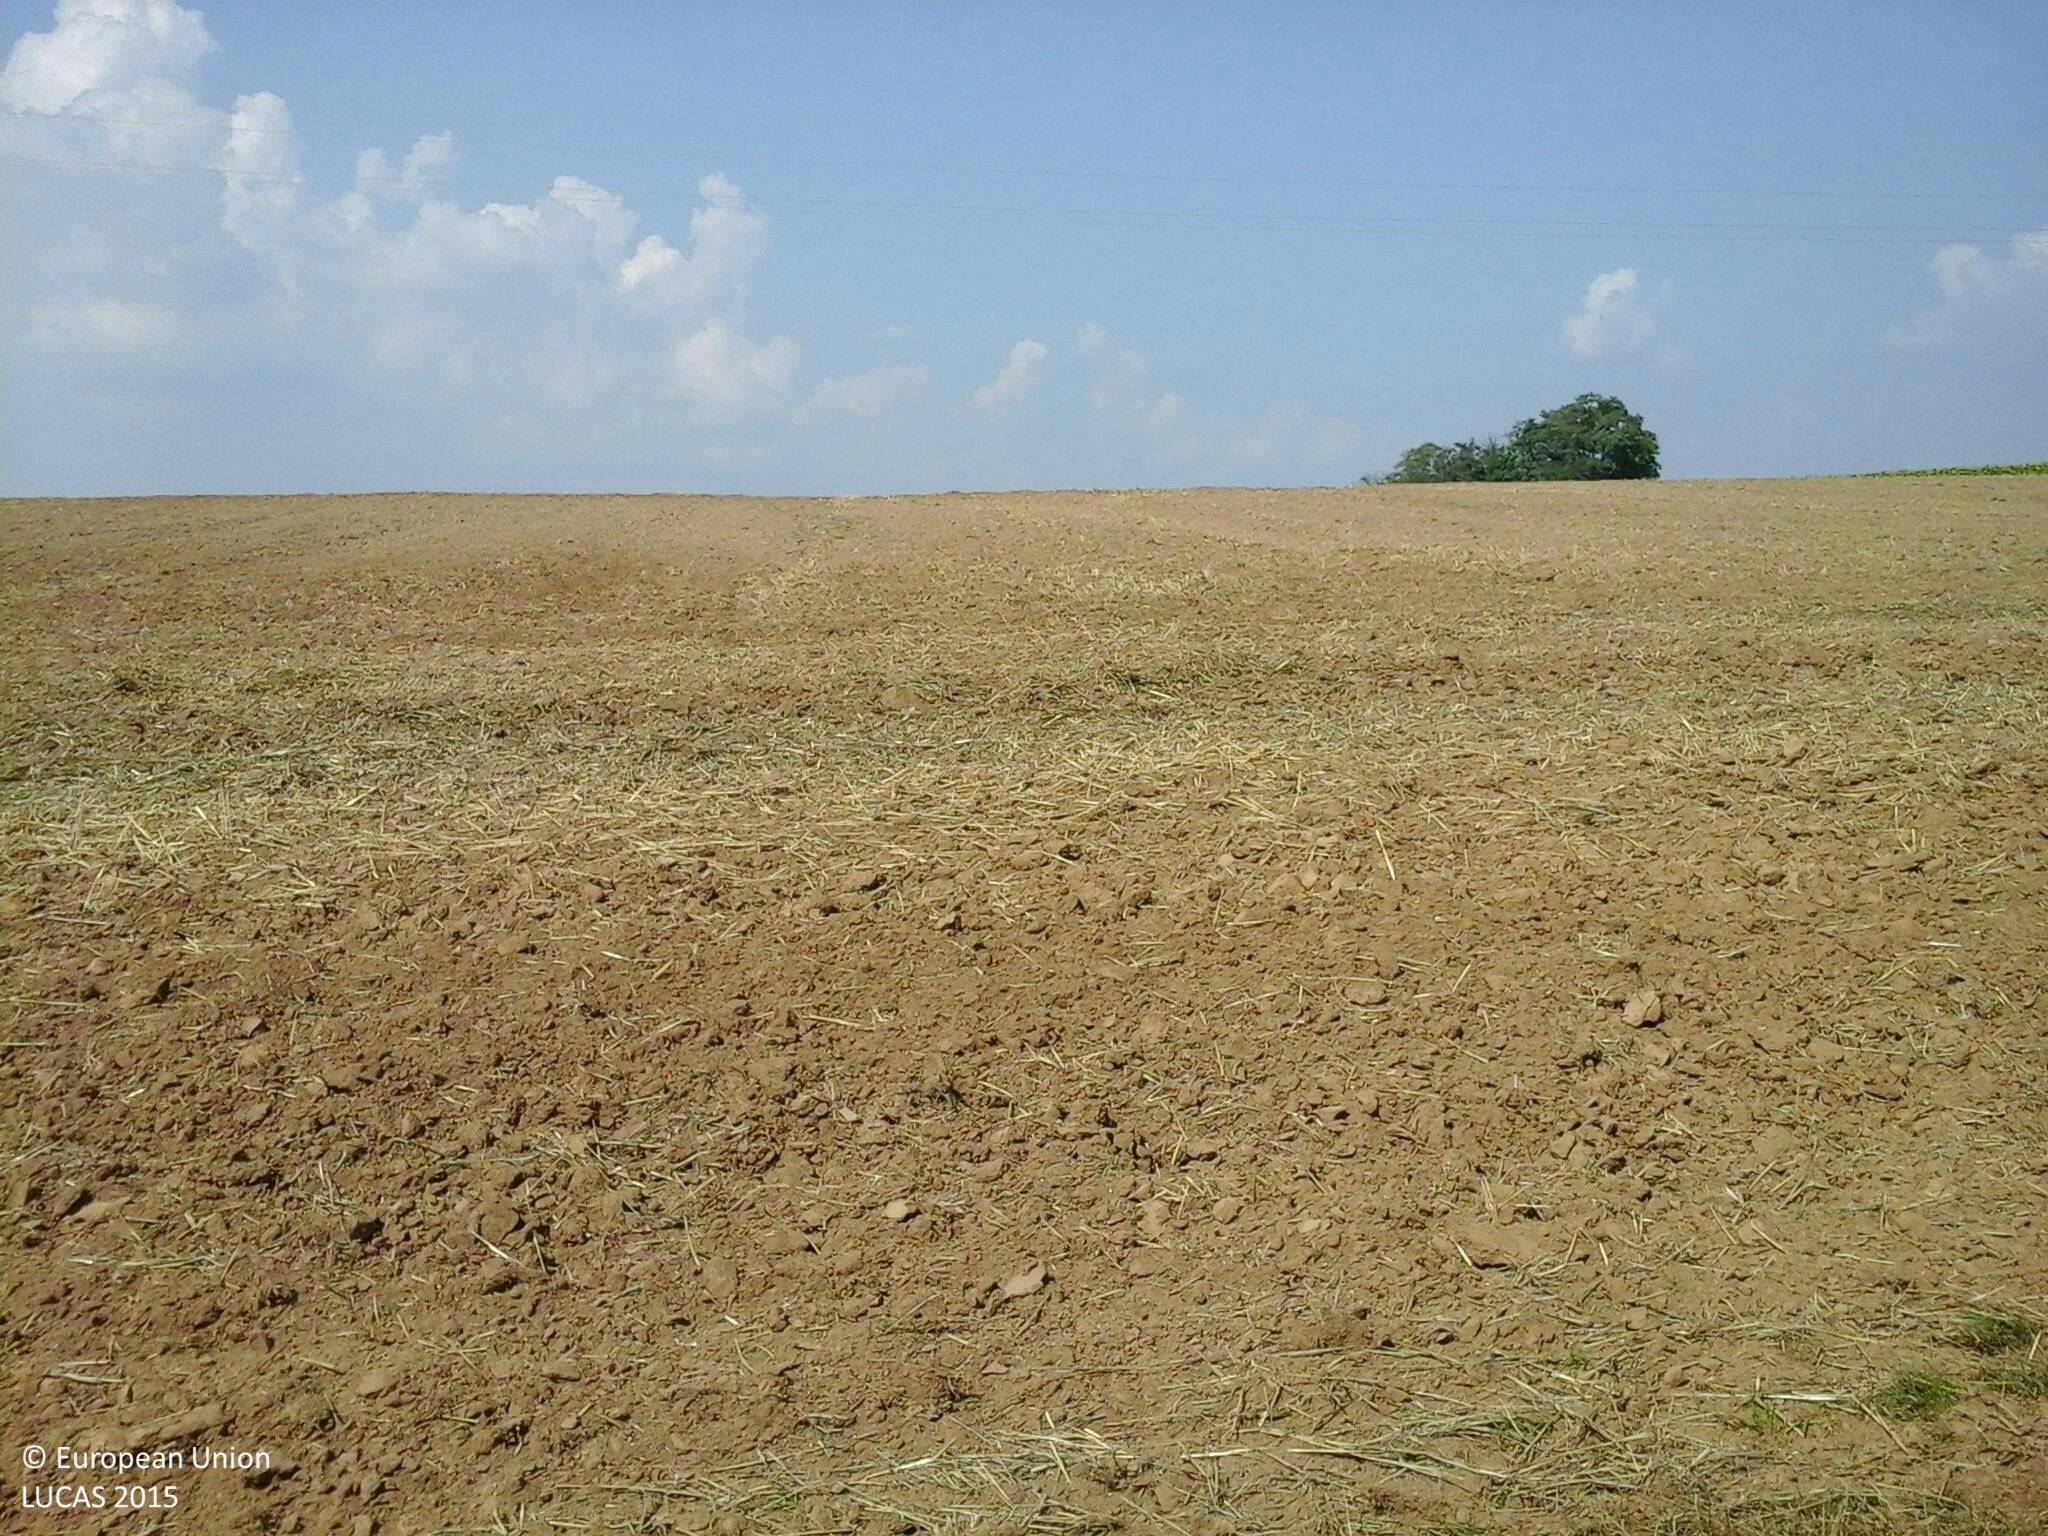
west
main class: Cropland
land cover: Sunflower
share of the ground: > 75 %
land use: Agriculture (excluding fallow land and kitchen gardens)
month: August
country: HU
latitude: 46.6529
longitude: 17.9392
